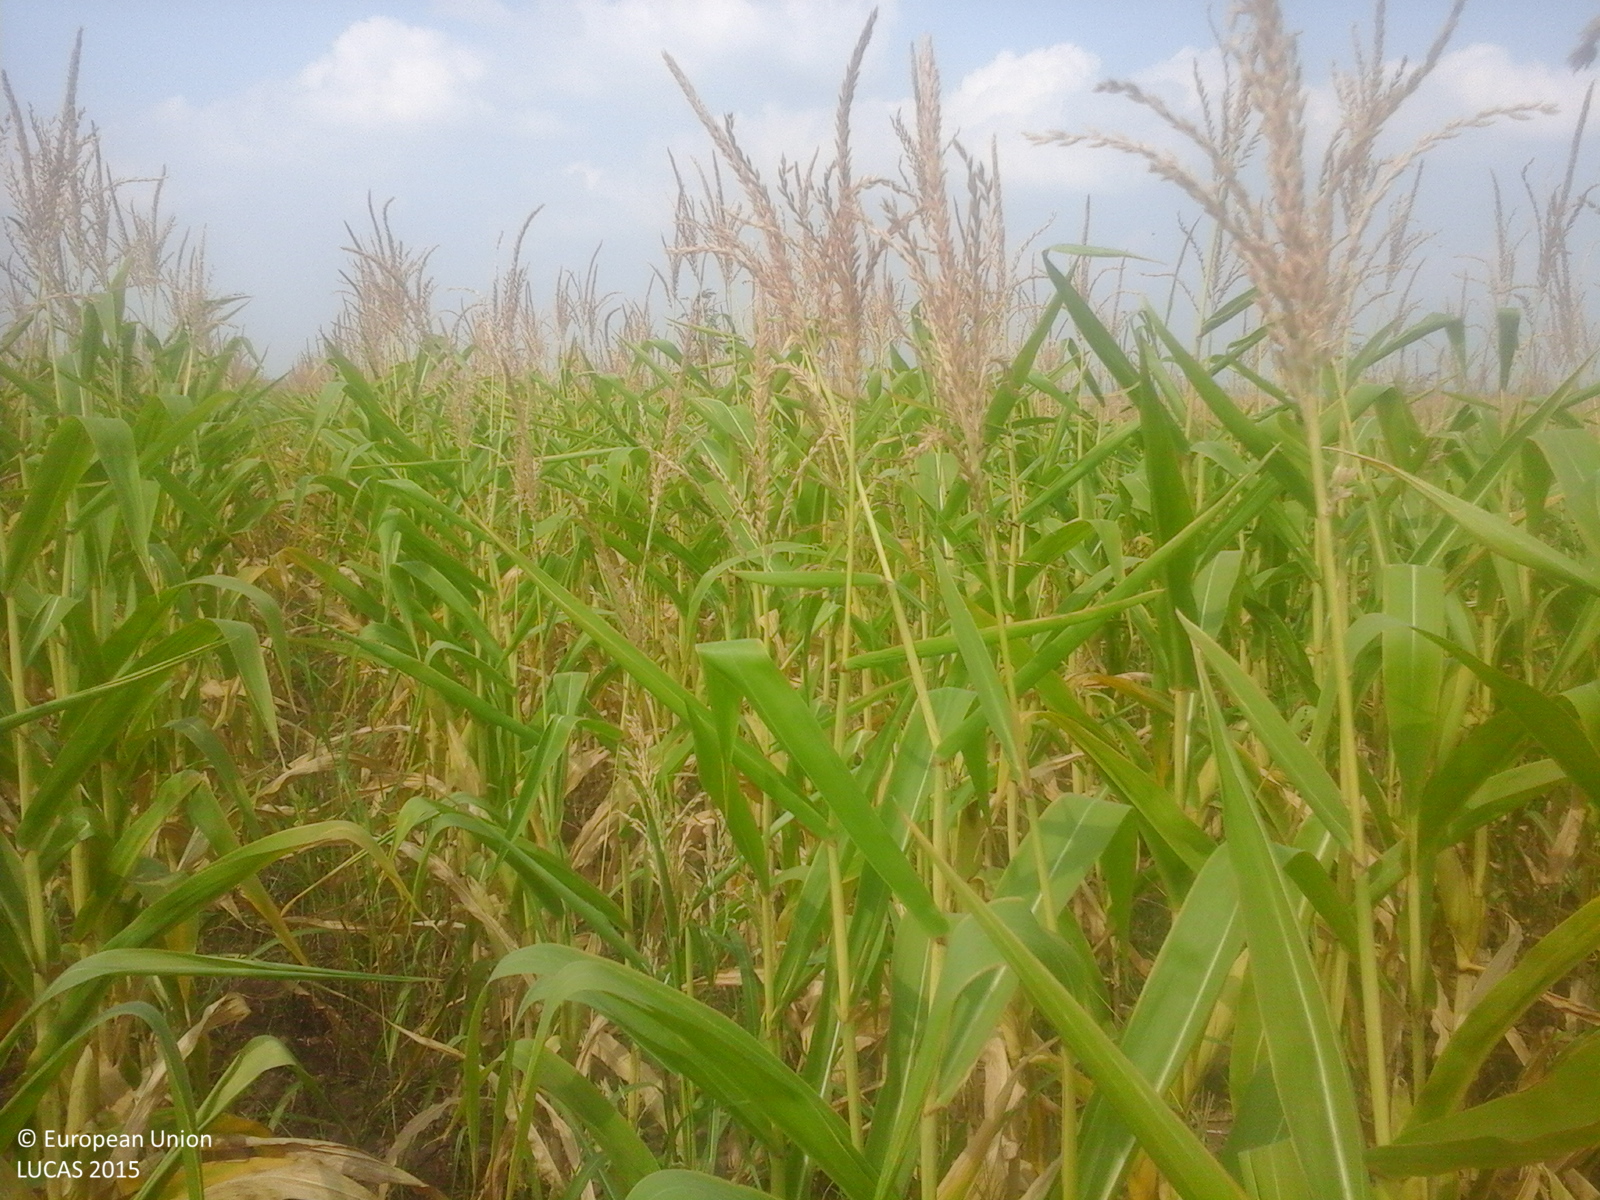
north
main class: Cropland
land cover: Maize
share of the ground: > 75 %
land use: Agriculture (excluding fallow land and kitchen gardens)
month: July
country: RO
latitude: 45.2604
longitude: 28.2579
